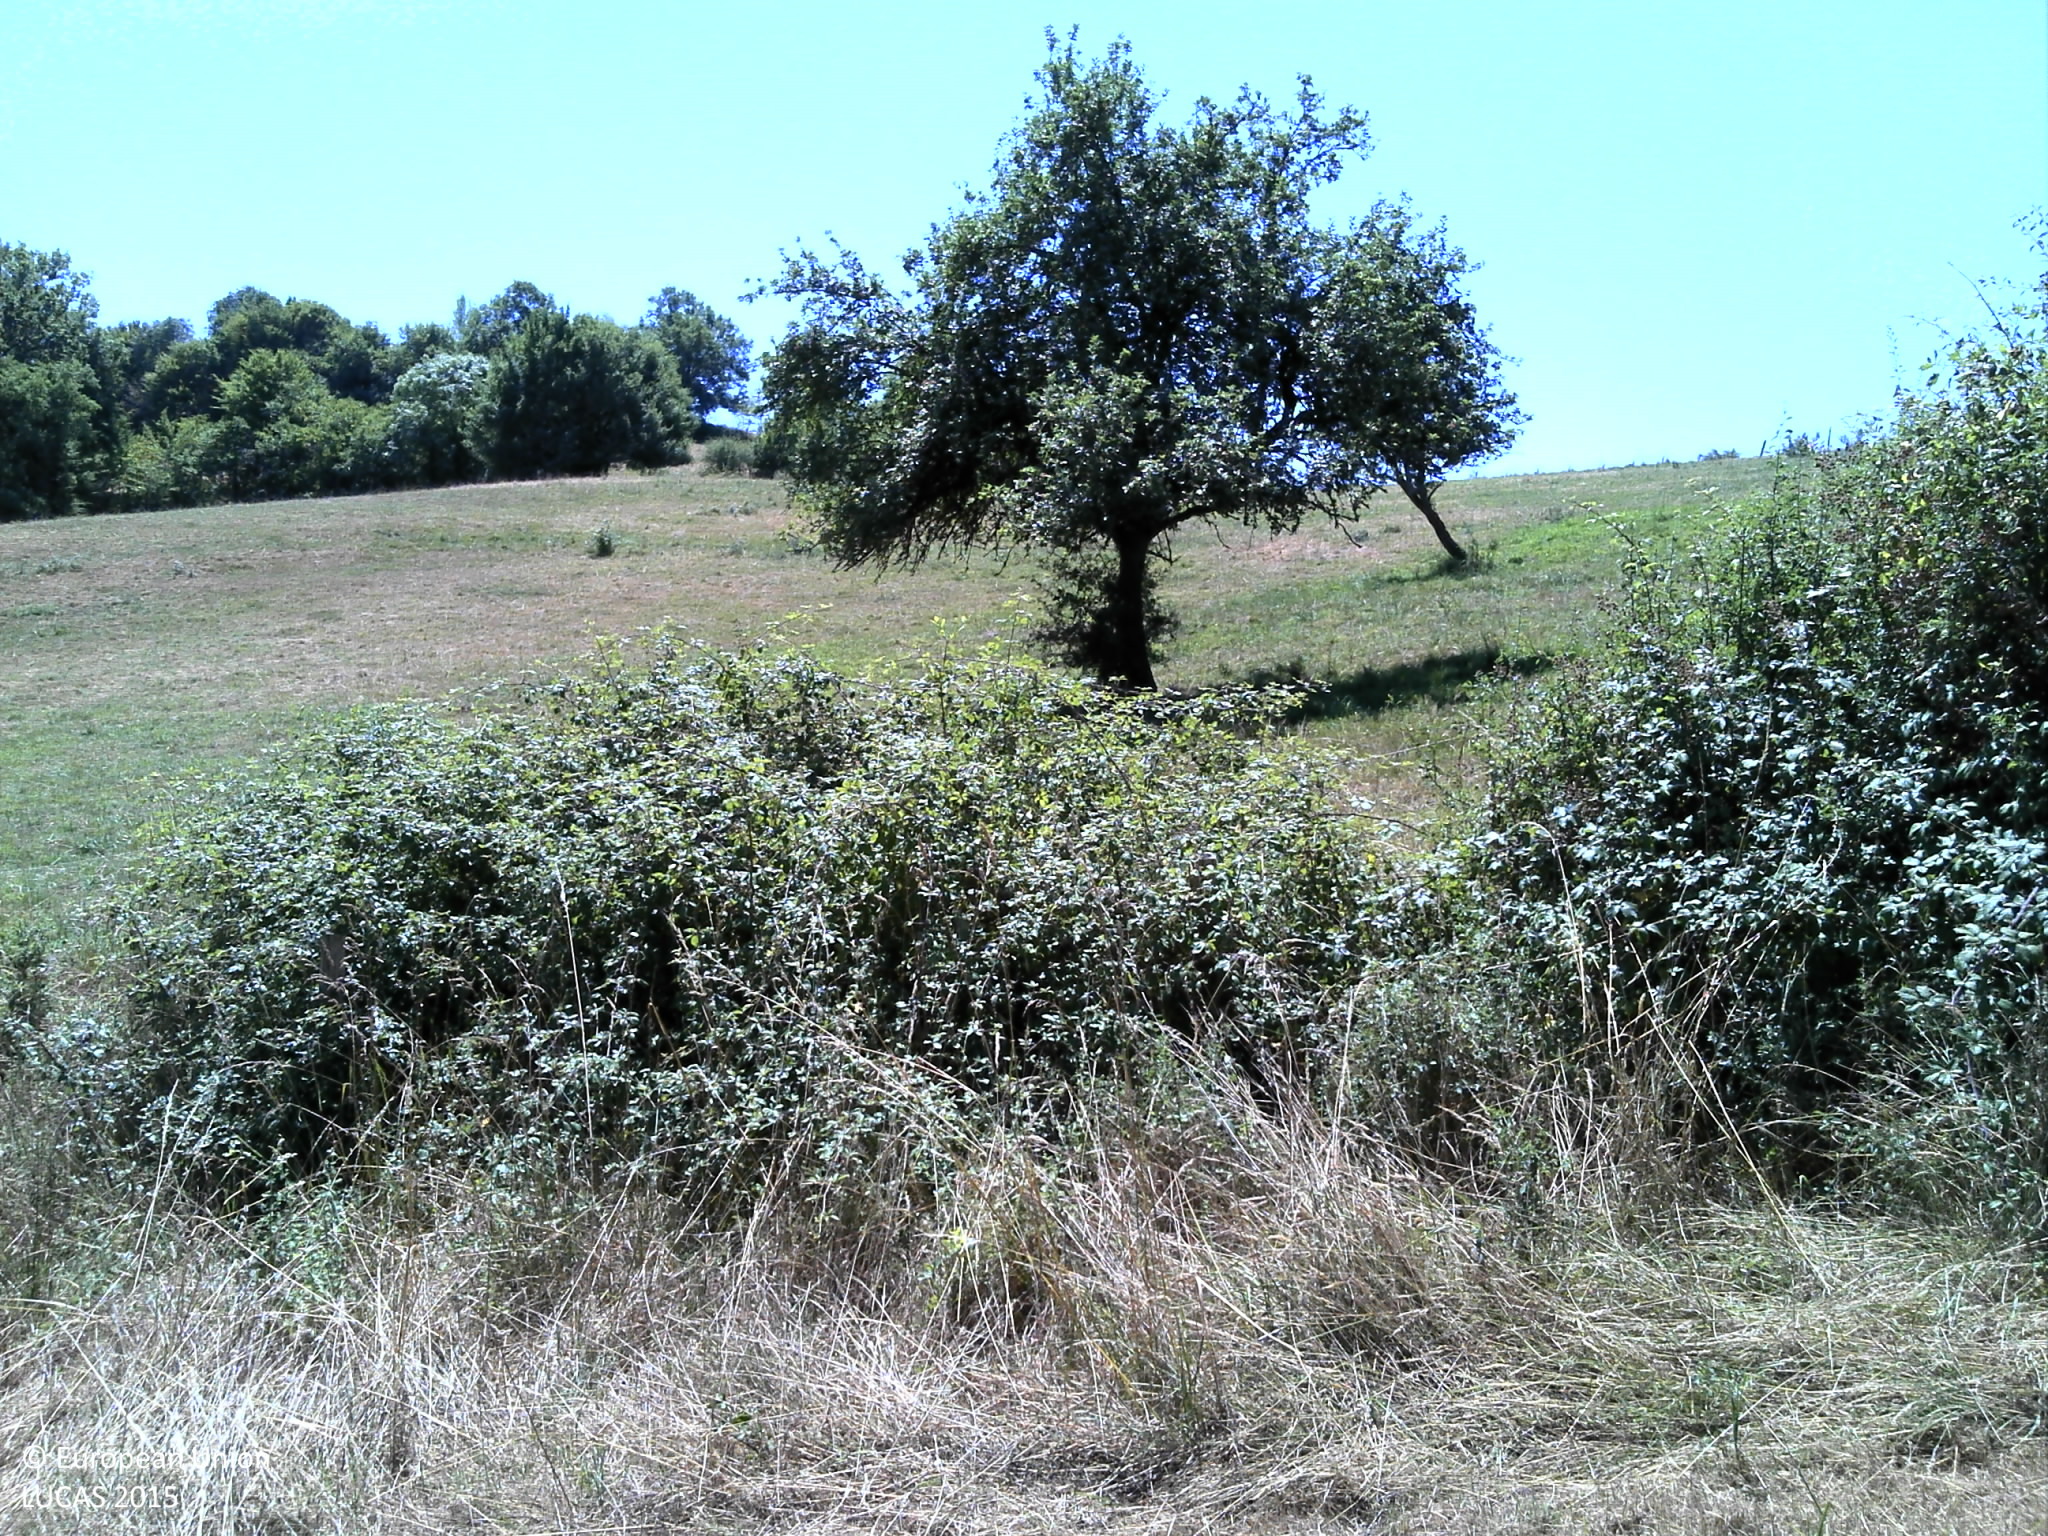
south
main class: Grassland
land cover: Grassland without tree/shrub cover
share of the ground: > 75 %
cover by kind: herbaceous plants 100 %
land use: Agriculture (excluding fallow land and kitchen gardens)
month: July
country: FR
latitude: 45.2156
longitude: 1.5015
